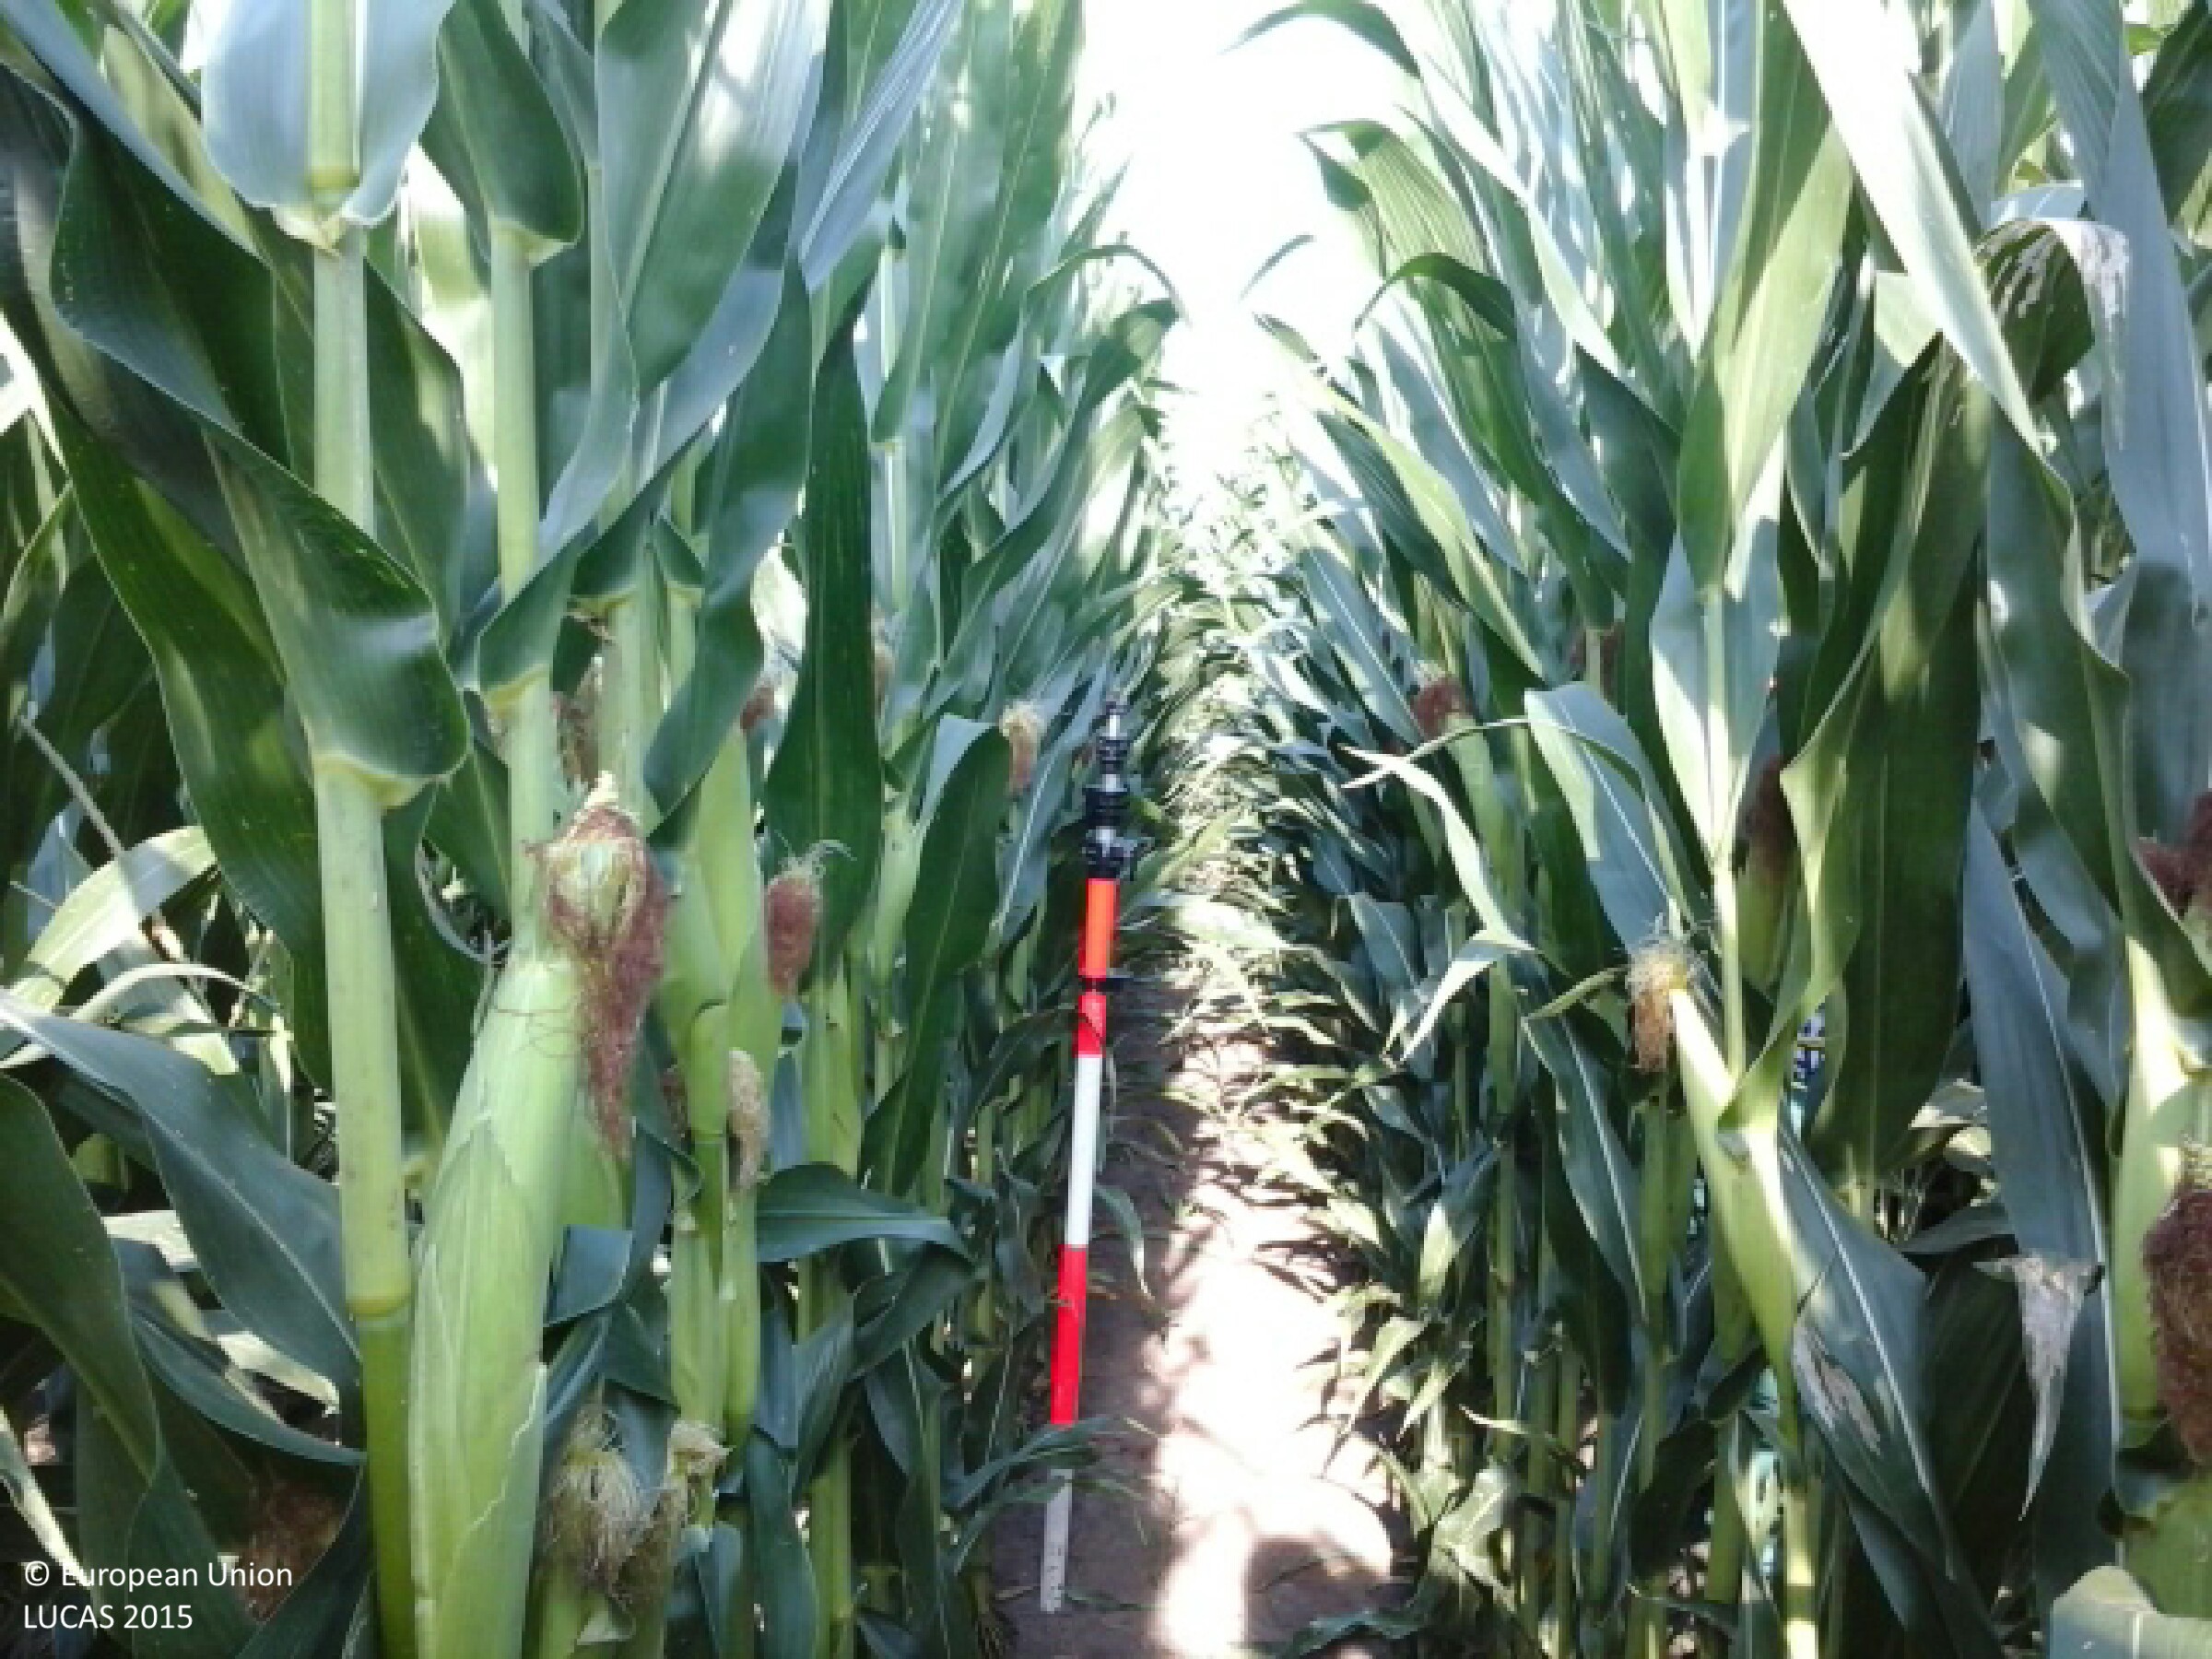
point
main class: Cropland
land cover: Maize
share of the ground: > 75 %
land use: Agriculture (excluding fallow land and kitchen gardens)
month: August
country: HU
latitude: 47.6839
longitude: 17.9373
